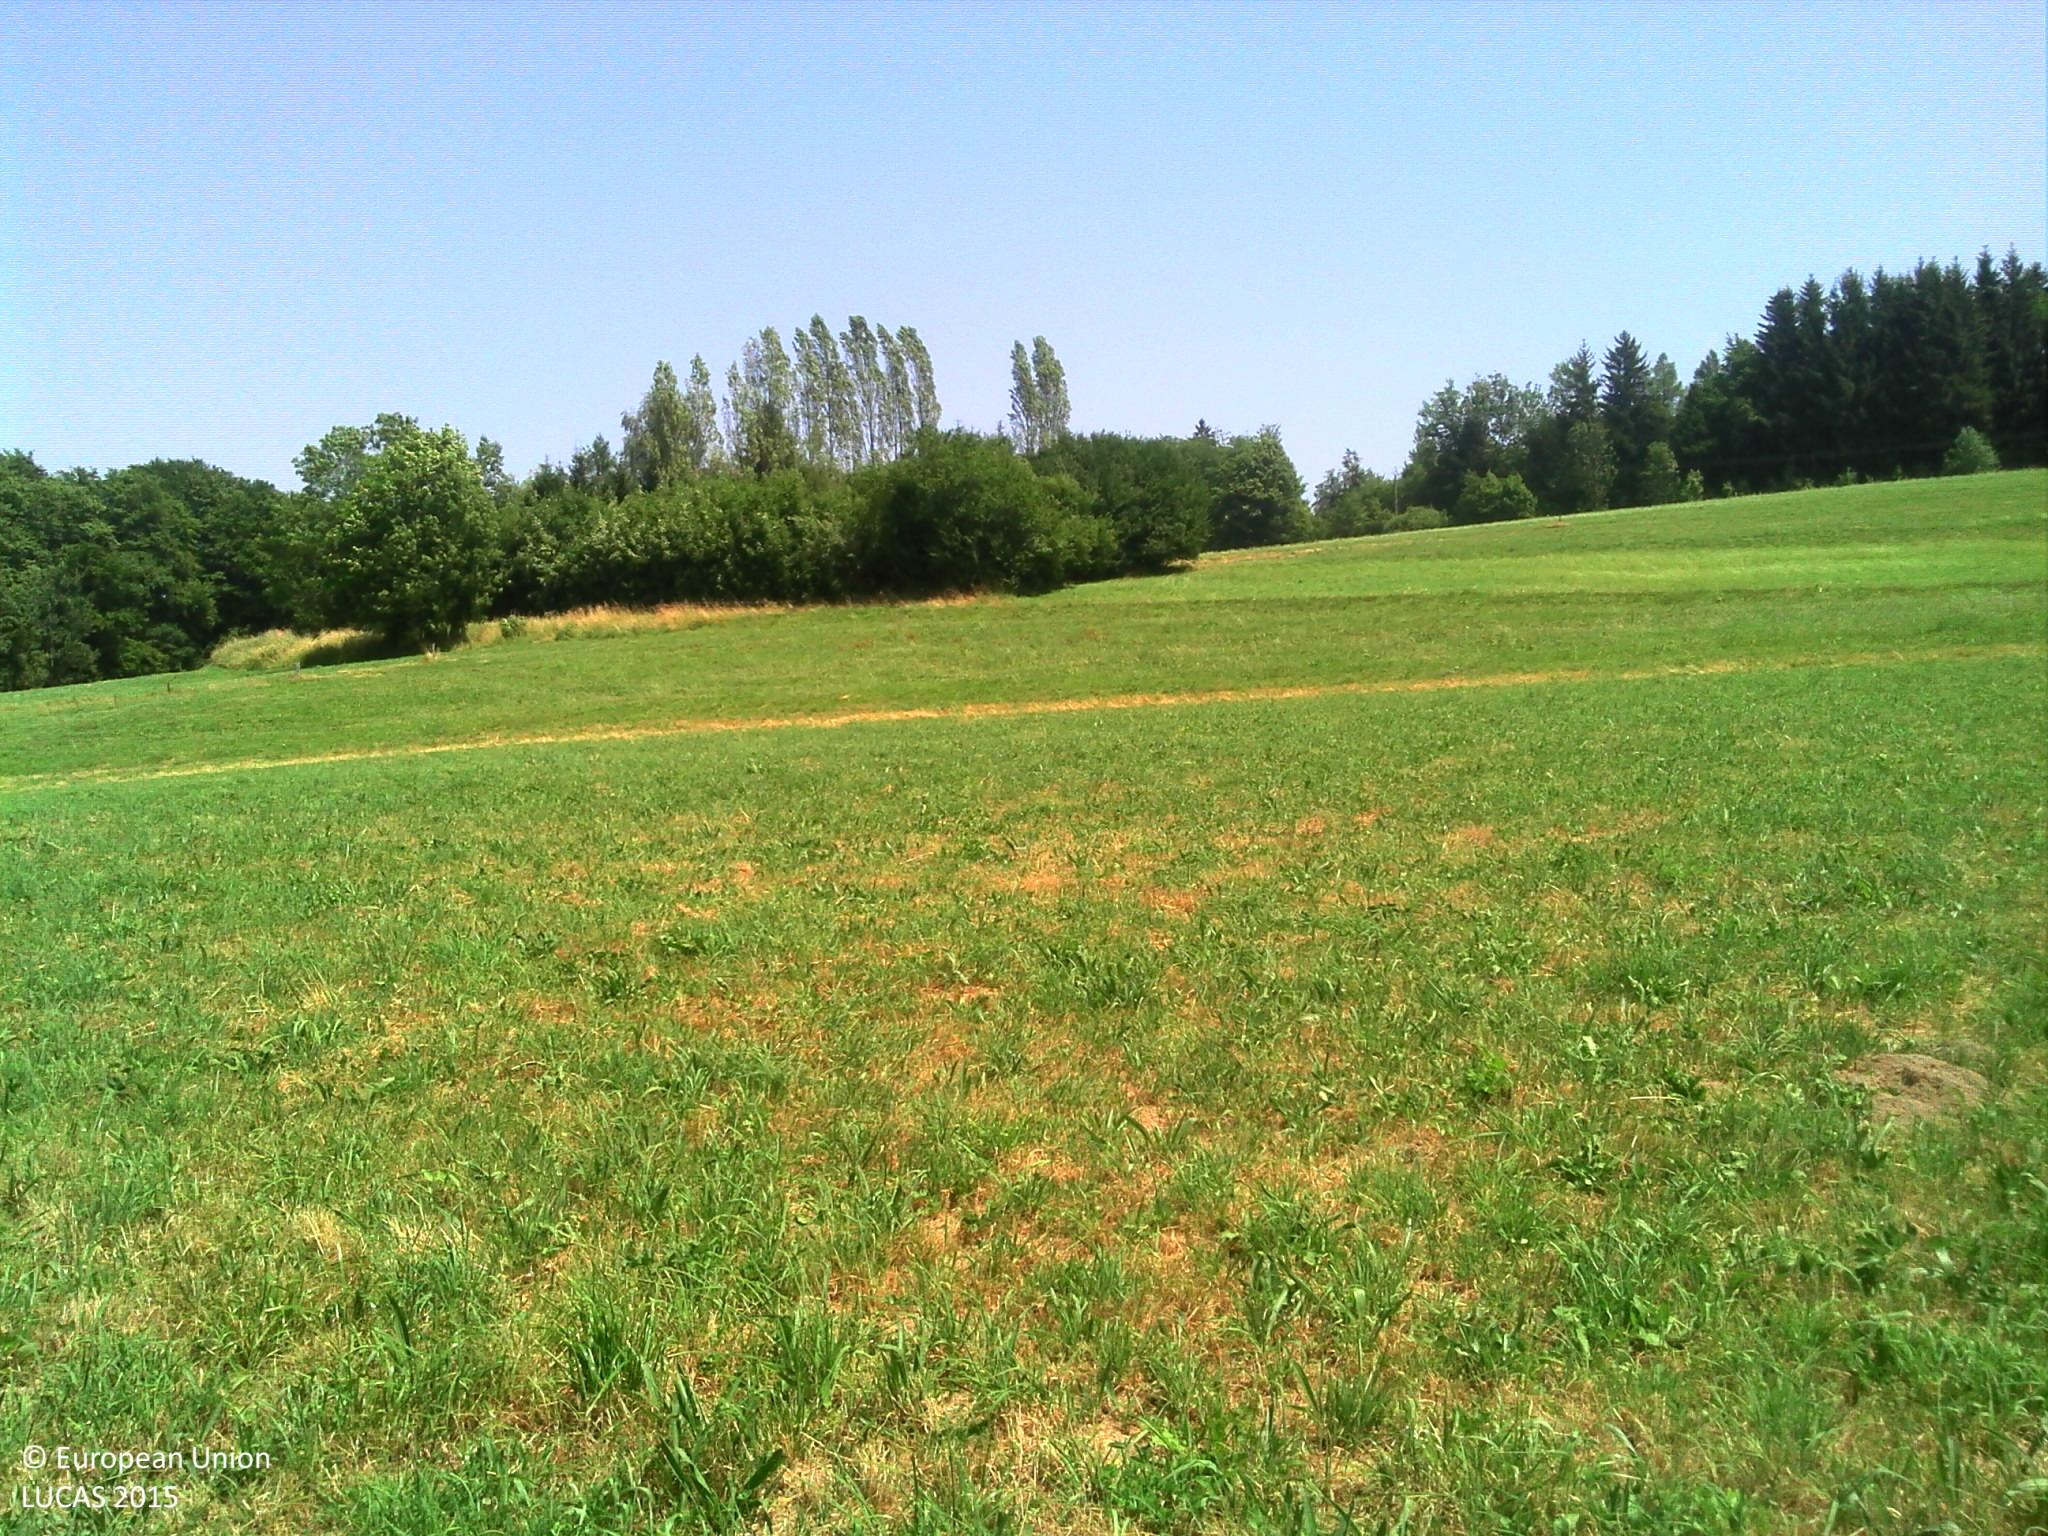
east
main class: Grassland
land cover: Grassland without tree/shrub cover
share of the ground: > 75 %
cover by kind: herbaceous plants 100 %
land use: Agriculture (excluding fallow land and kitchen gardens)
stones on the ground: < 10 %
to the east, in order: Grassland without tree/shrub cover; Paved roads, cycling and walking lanes; Grass margins; Ditches and canals; Grassland without tree/shrub cover; Paved roads, cycling and walking lanes; Ditches and canals; Grassland without tree/shrub cover; Other leguminous and mixtures for fodder; Lines of trees; Fences; Grassland without tree/shrub cover; Electric lines; Grassland without tree/shrub cover
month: July
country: FR
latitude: 46.0850
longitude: 6.1886
